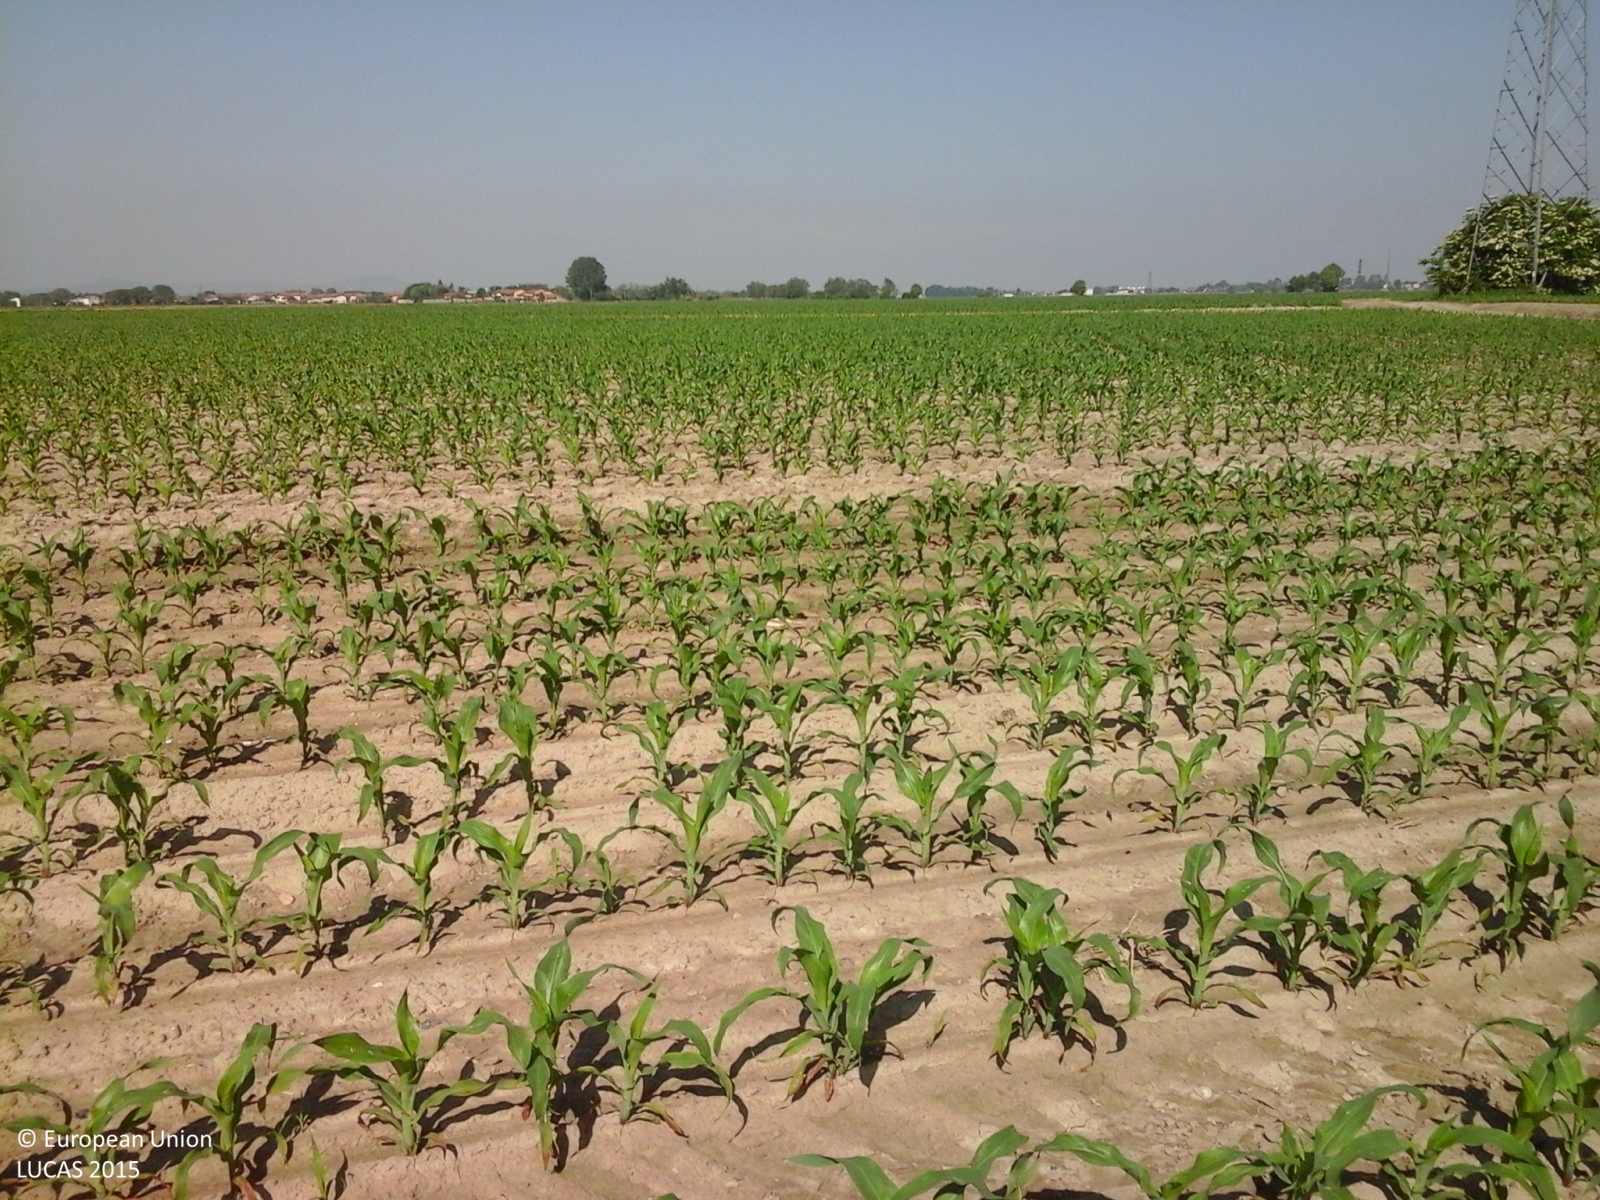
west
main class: Cropland
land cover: Maize
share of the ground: 25 - 50 %
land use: Agriculture (excluding fallow land and kitchen gardens)
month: May
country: IT
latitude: 45.1684
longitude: 8.4379
